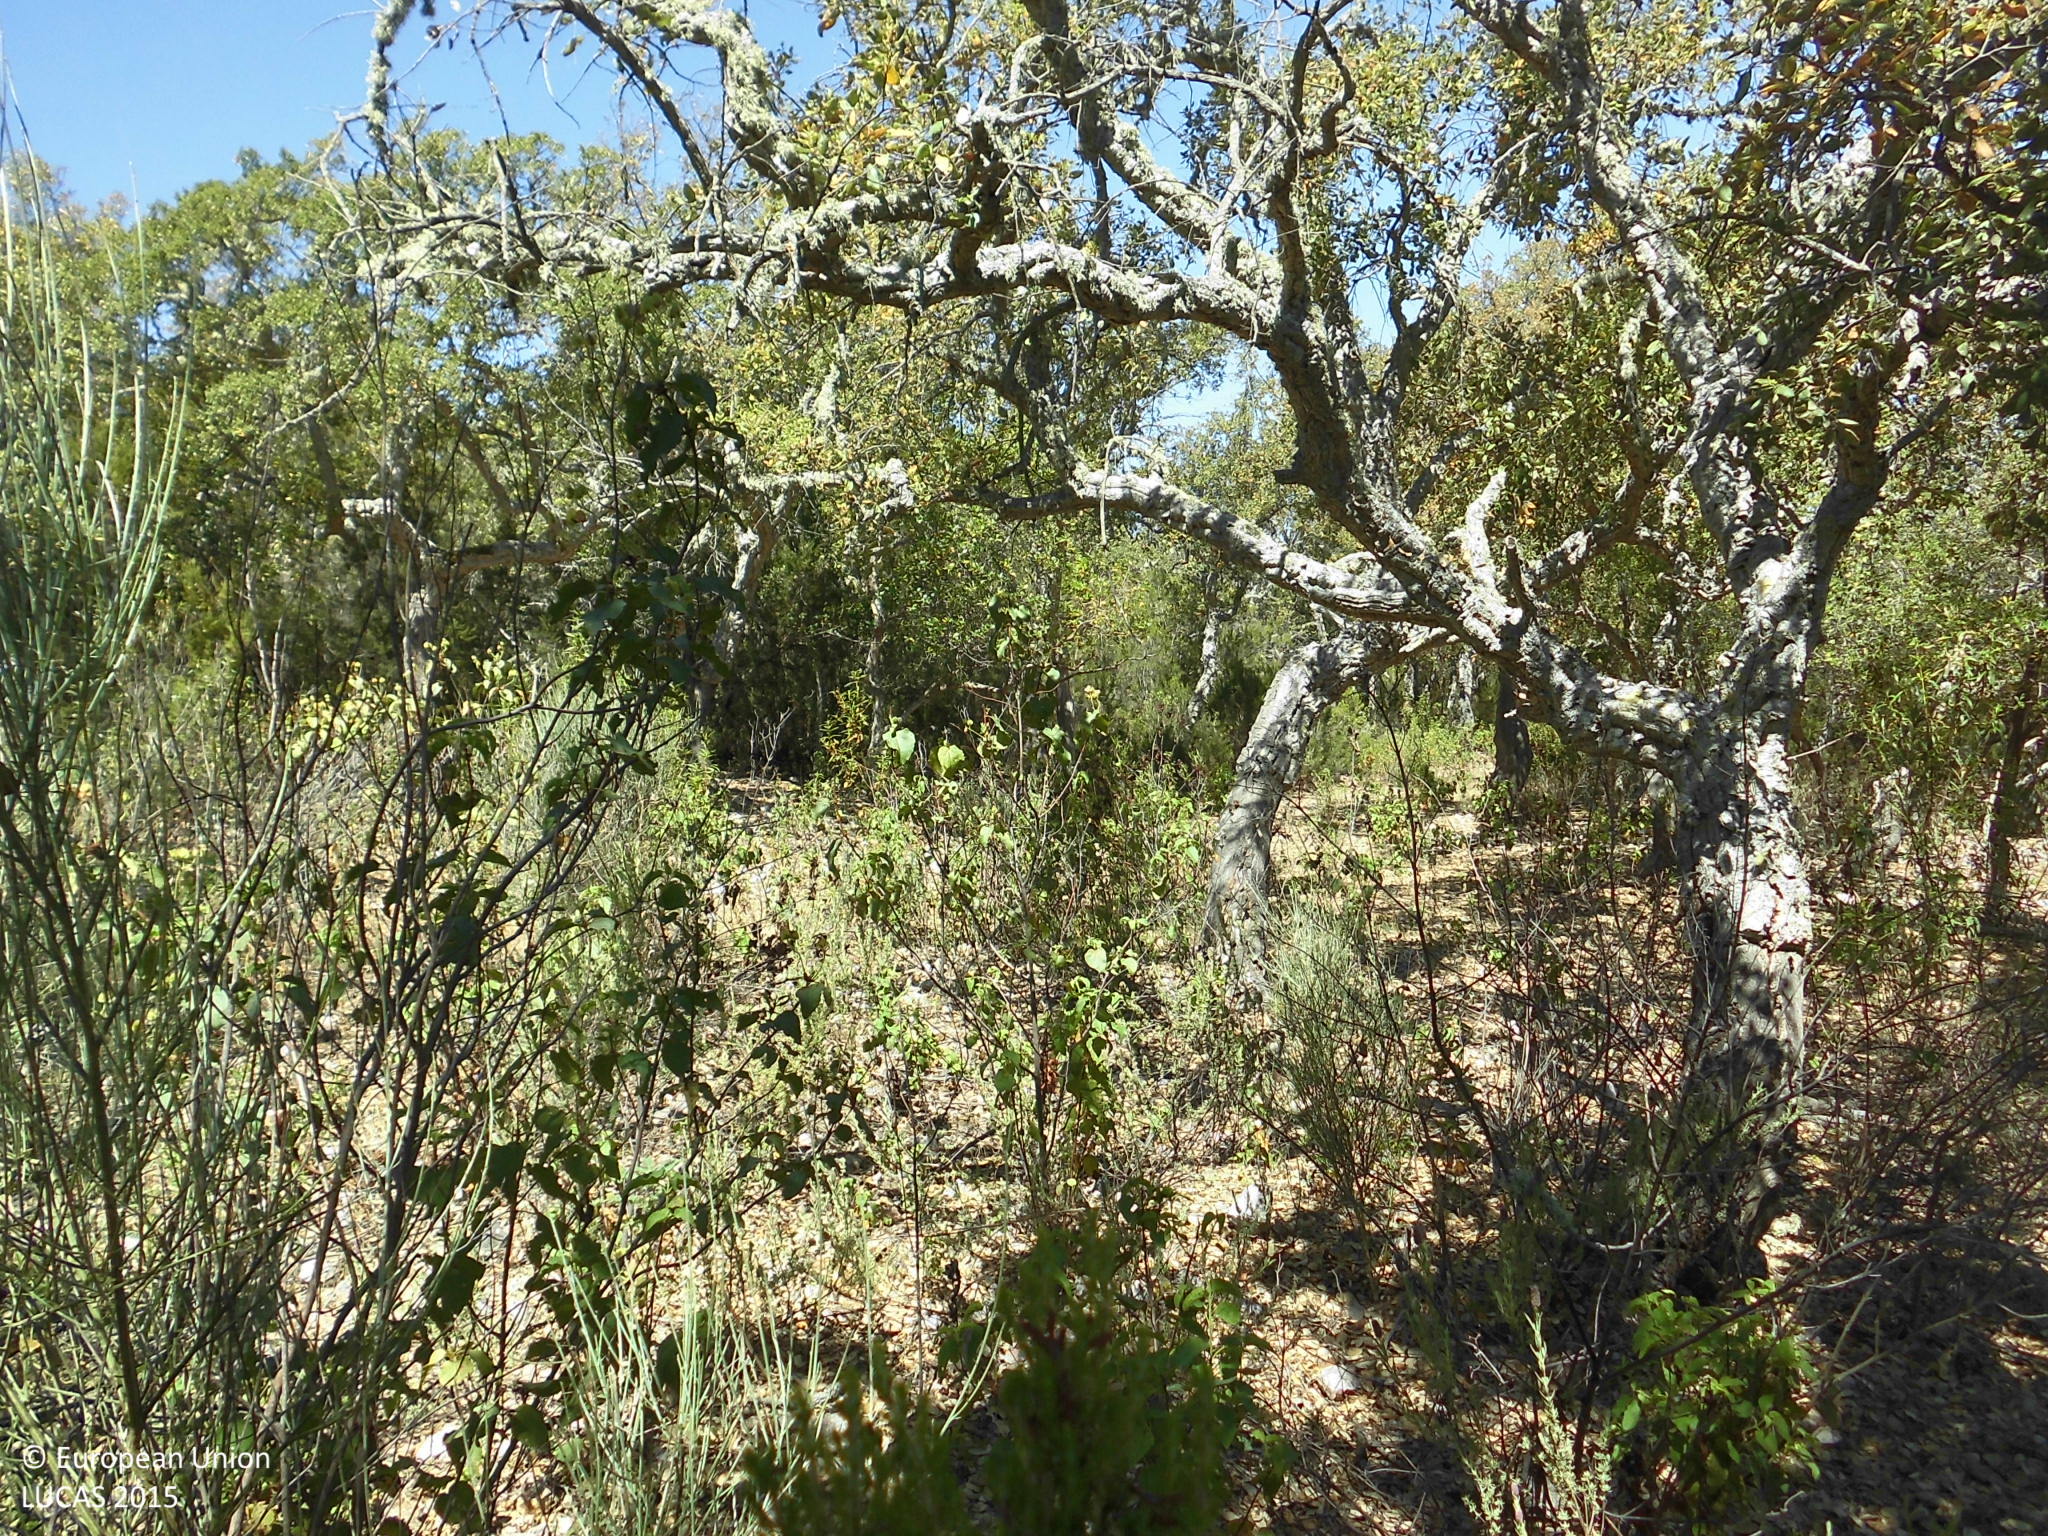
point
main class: Woodland
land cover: Broadleaved woodland
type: broadleaved evergreen forest
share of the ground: > 75 %
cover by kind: broadleaved forest trees 75 %, shrubs 25 %
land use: Forestry
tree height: > 5 m
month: May
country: ES
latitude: 39.4434
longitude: -7.0582
